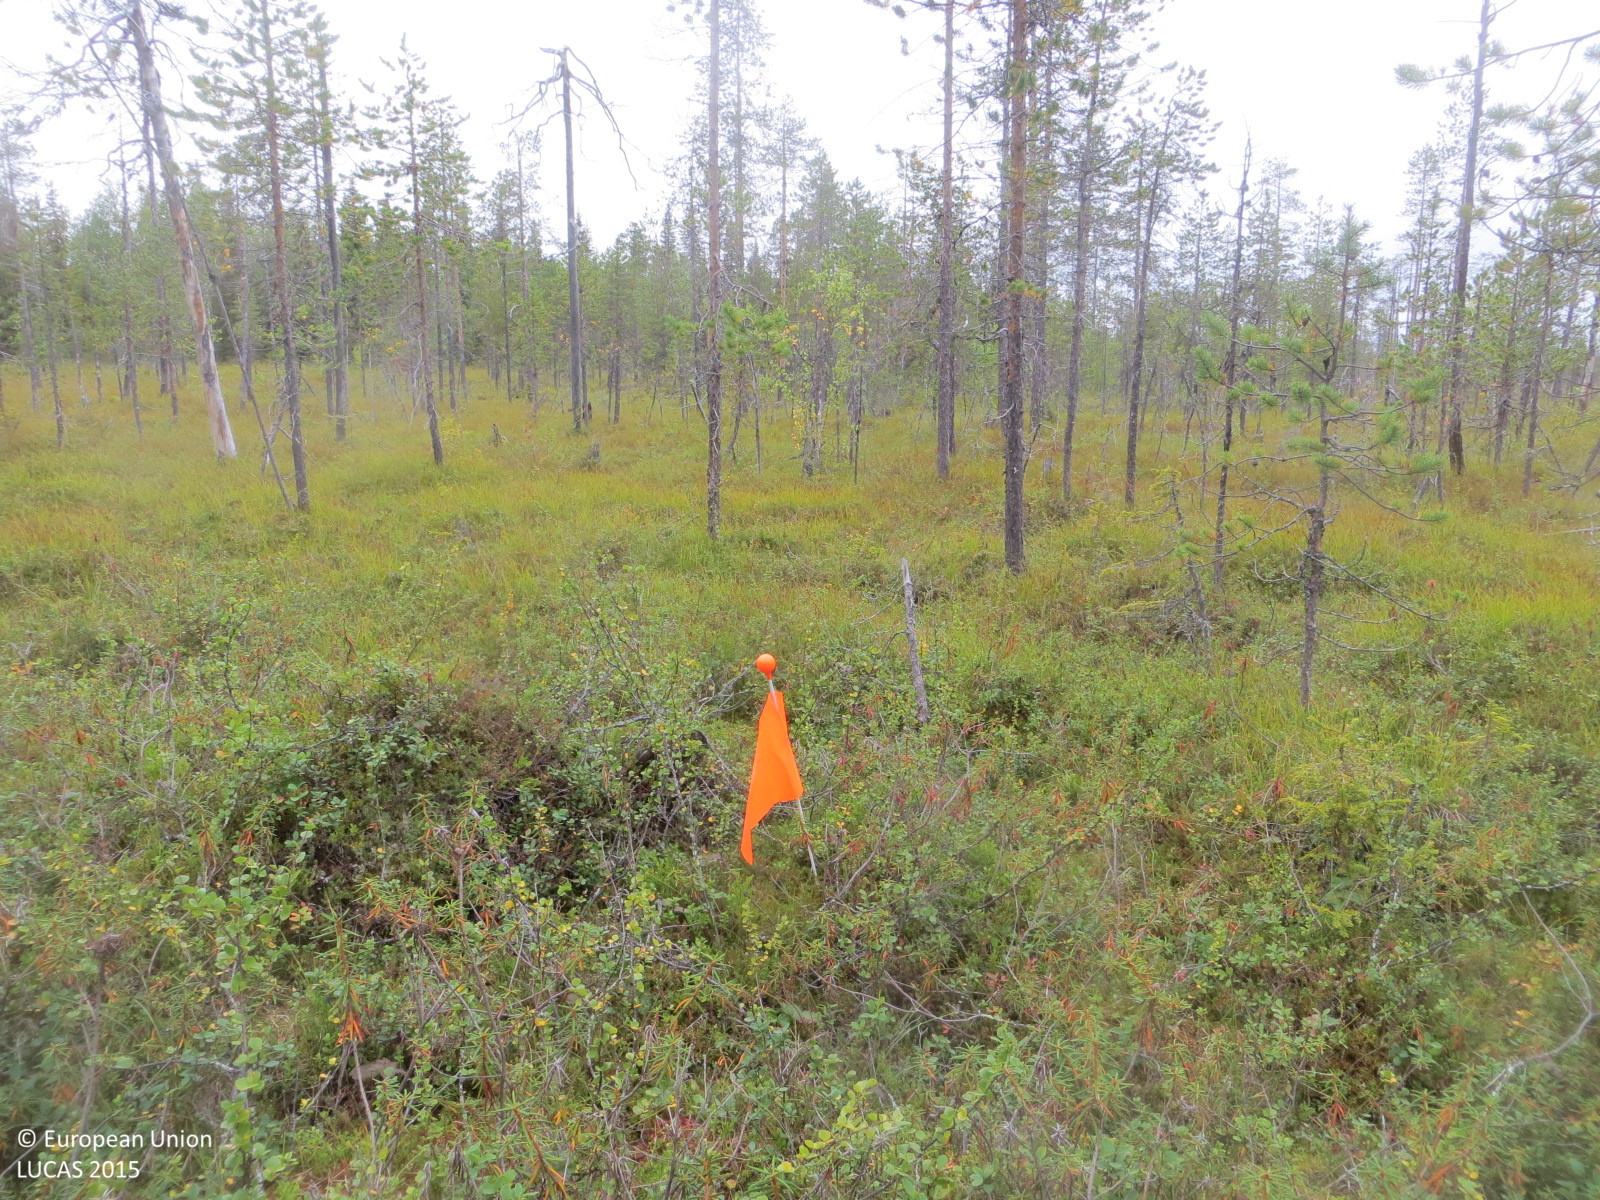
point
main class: Woodland
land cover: Pine dominated coniferous woodland
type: mire and swamp forests
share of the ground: 25 - 50 %
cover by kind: coniferous forest trees 45 %, herbaceous plants 30 %, shrubs 25 %
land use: Forestry
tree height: > 5 m
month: August
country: FI
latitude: 67.5117
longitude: 24.2949
